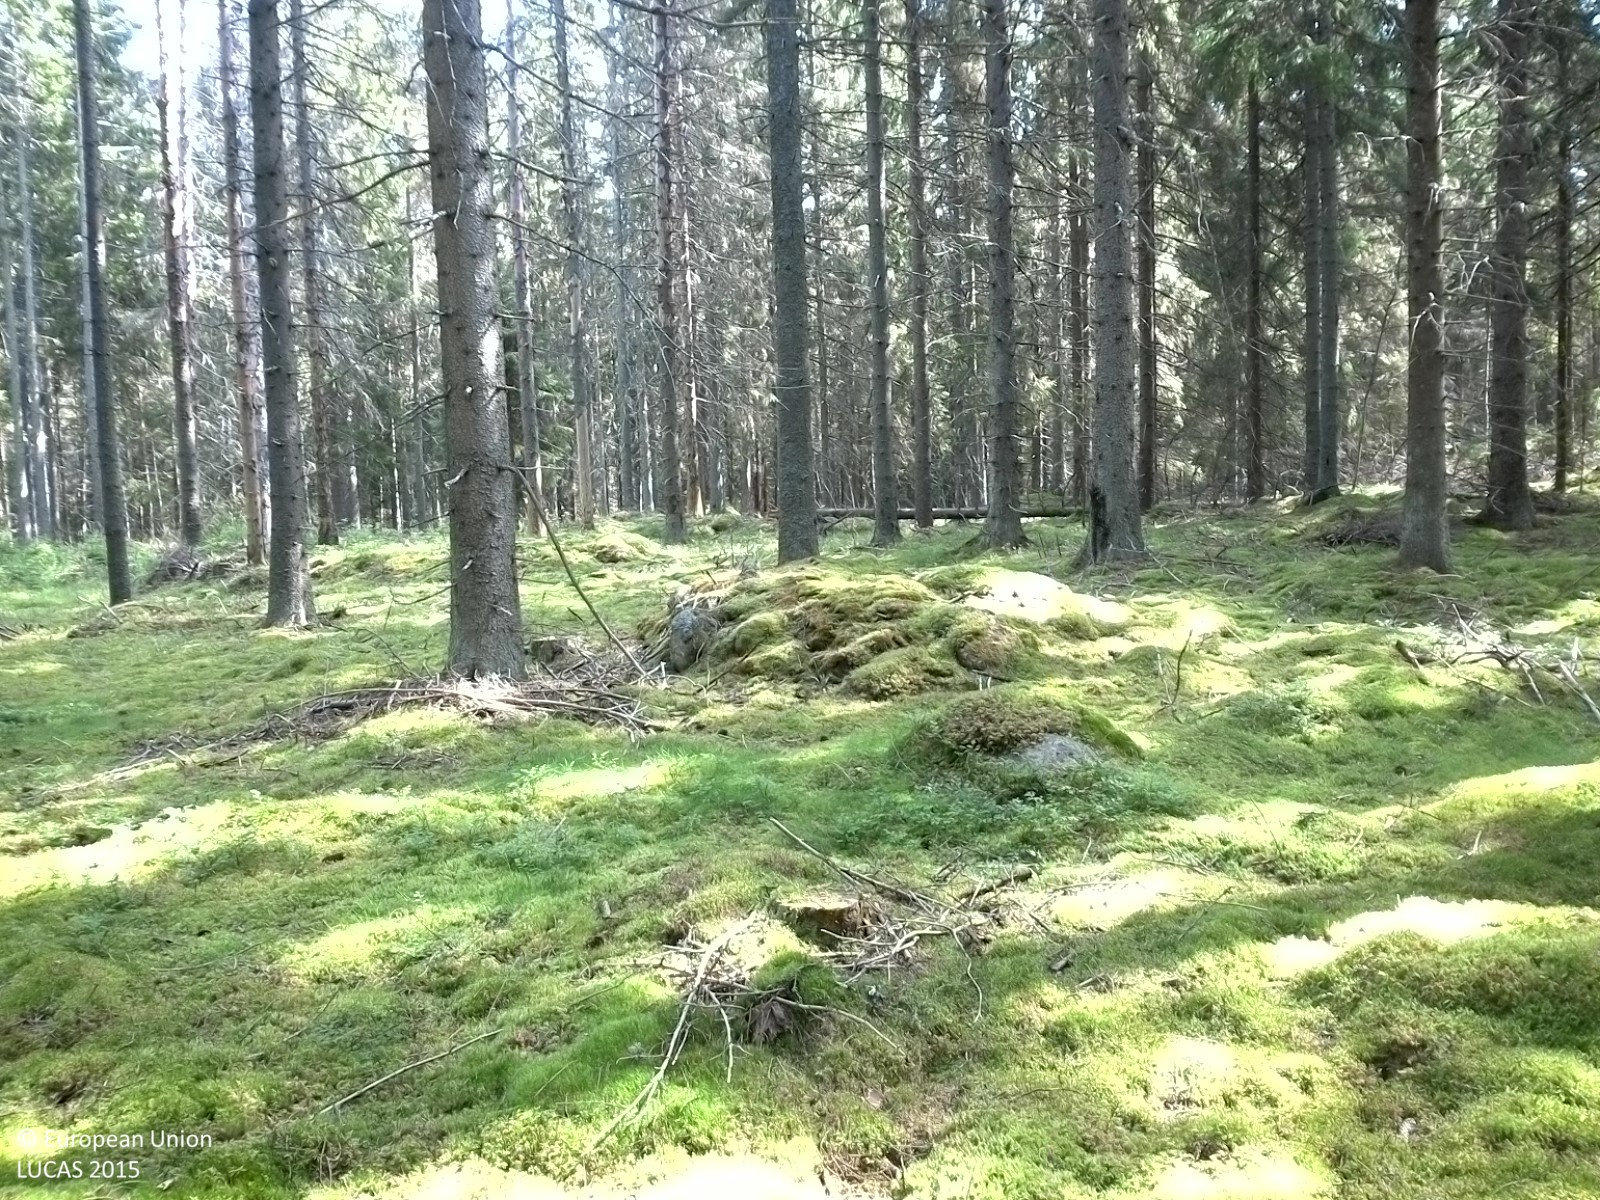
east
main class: Woodland
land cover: Spruce dominated coniferous woodland
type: boreal forest
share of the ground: 50 - 75 %
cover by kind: coniferous forest trees 60 %, lichens and mosses 30 %, herbaceous plants 10 %
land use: Forestry
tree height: > 5 m
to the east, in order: Spruce dominated coniferous woodland; Tracks; Spruce dominated coniferous woodland; Spruce dominated mixed woodland; Ditches and canals; Spruce dominated mixed woodland; Pine dominated mixed woodland; Spruce dominated mixed woodland
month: August
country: SE
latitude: 59.0536
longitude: 14.7866
